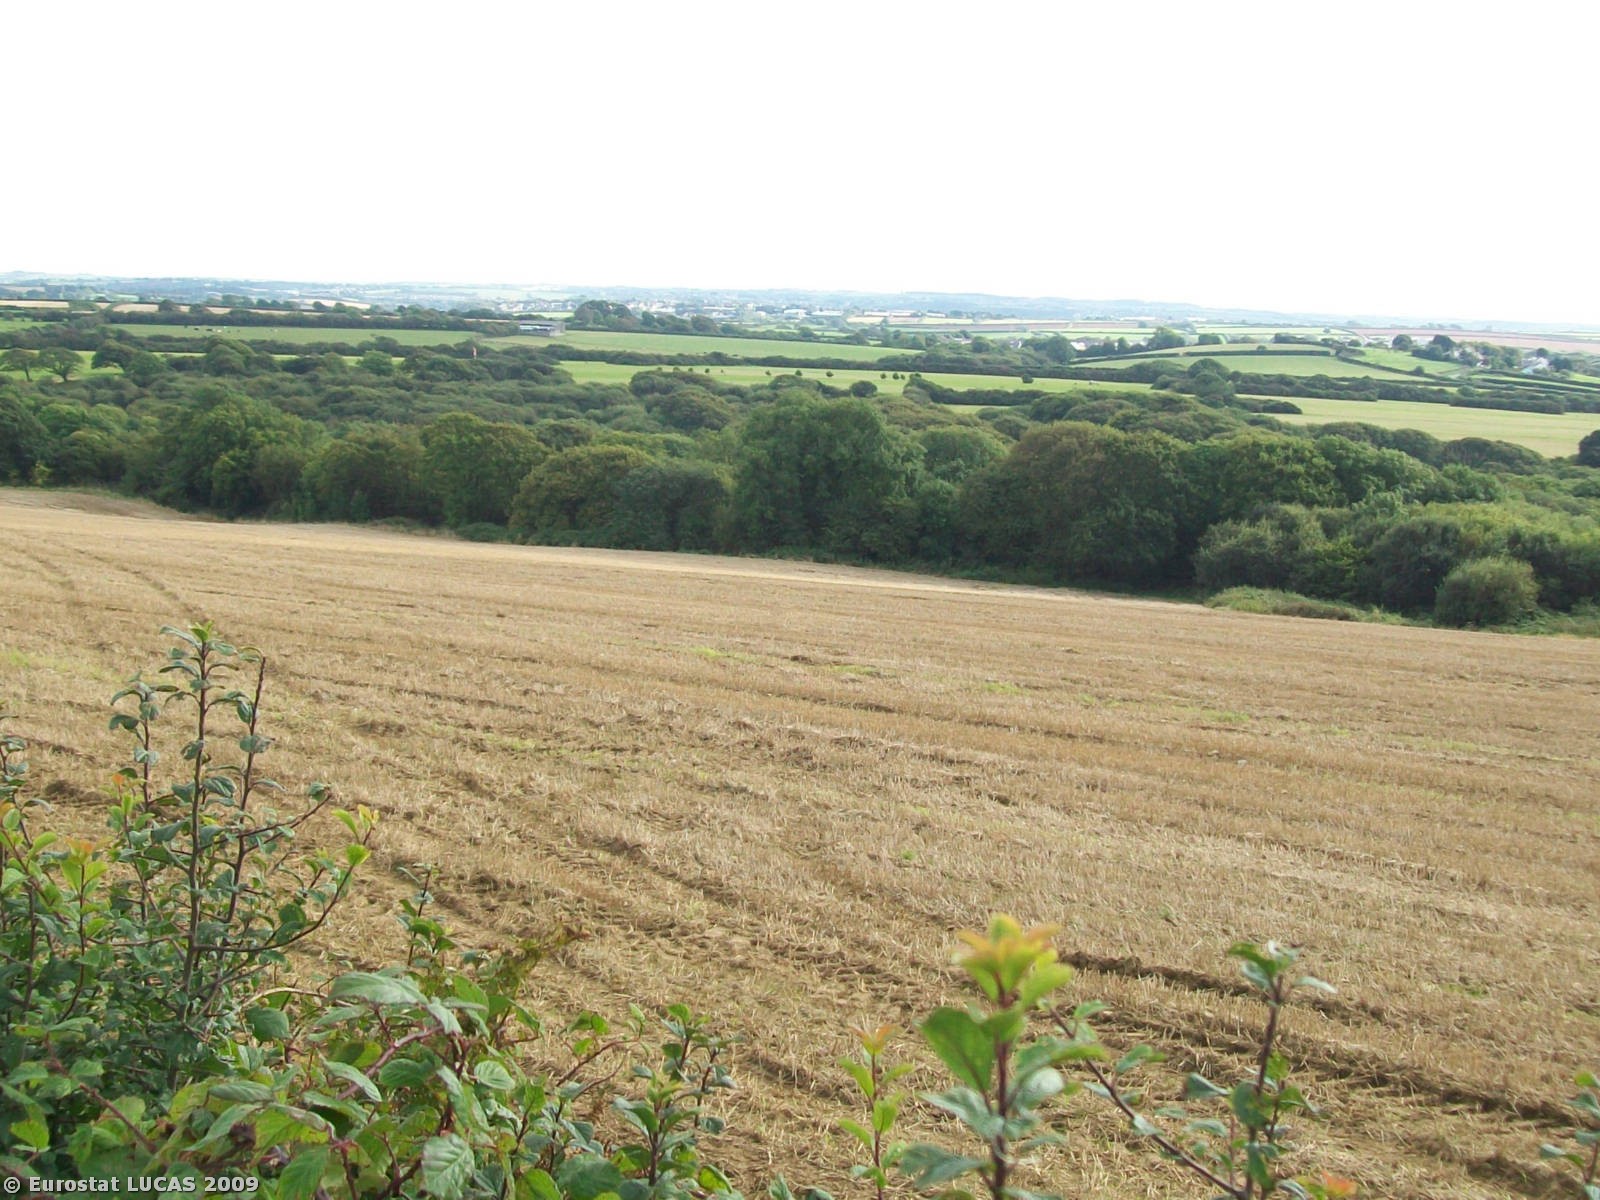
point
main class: Cropland
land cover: Common wheat
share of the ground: 10 - 25 %
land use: Agriculture (excluding fallow land and kitchen gardens)
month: September
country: GB
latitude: 51.7509
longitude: -4.9637
